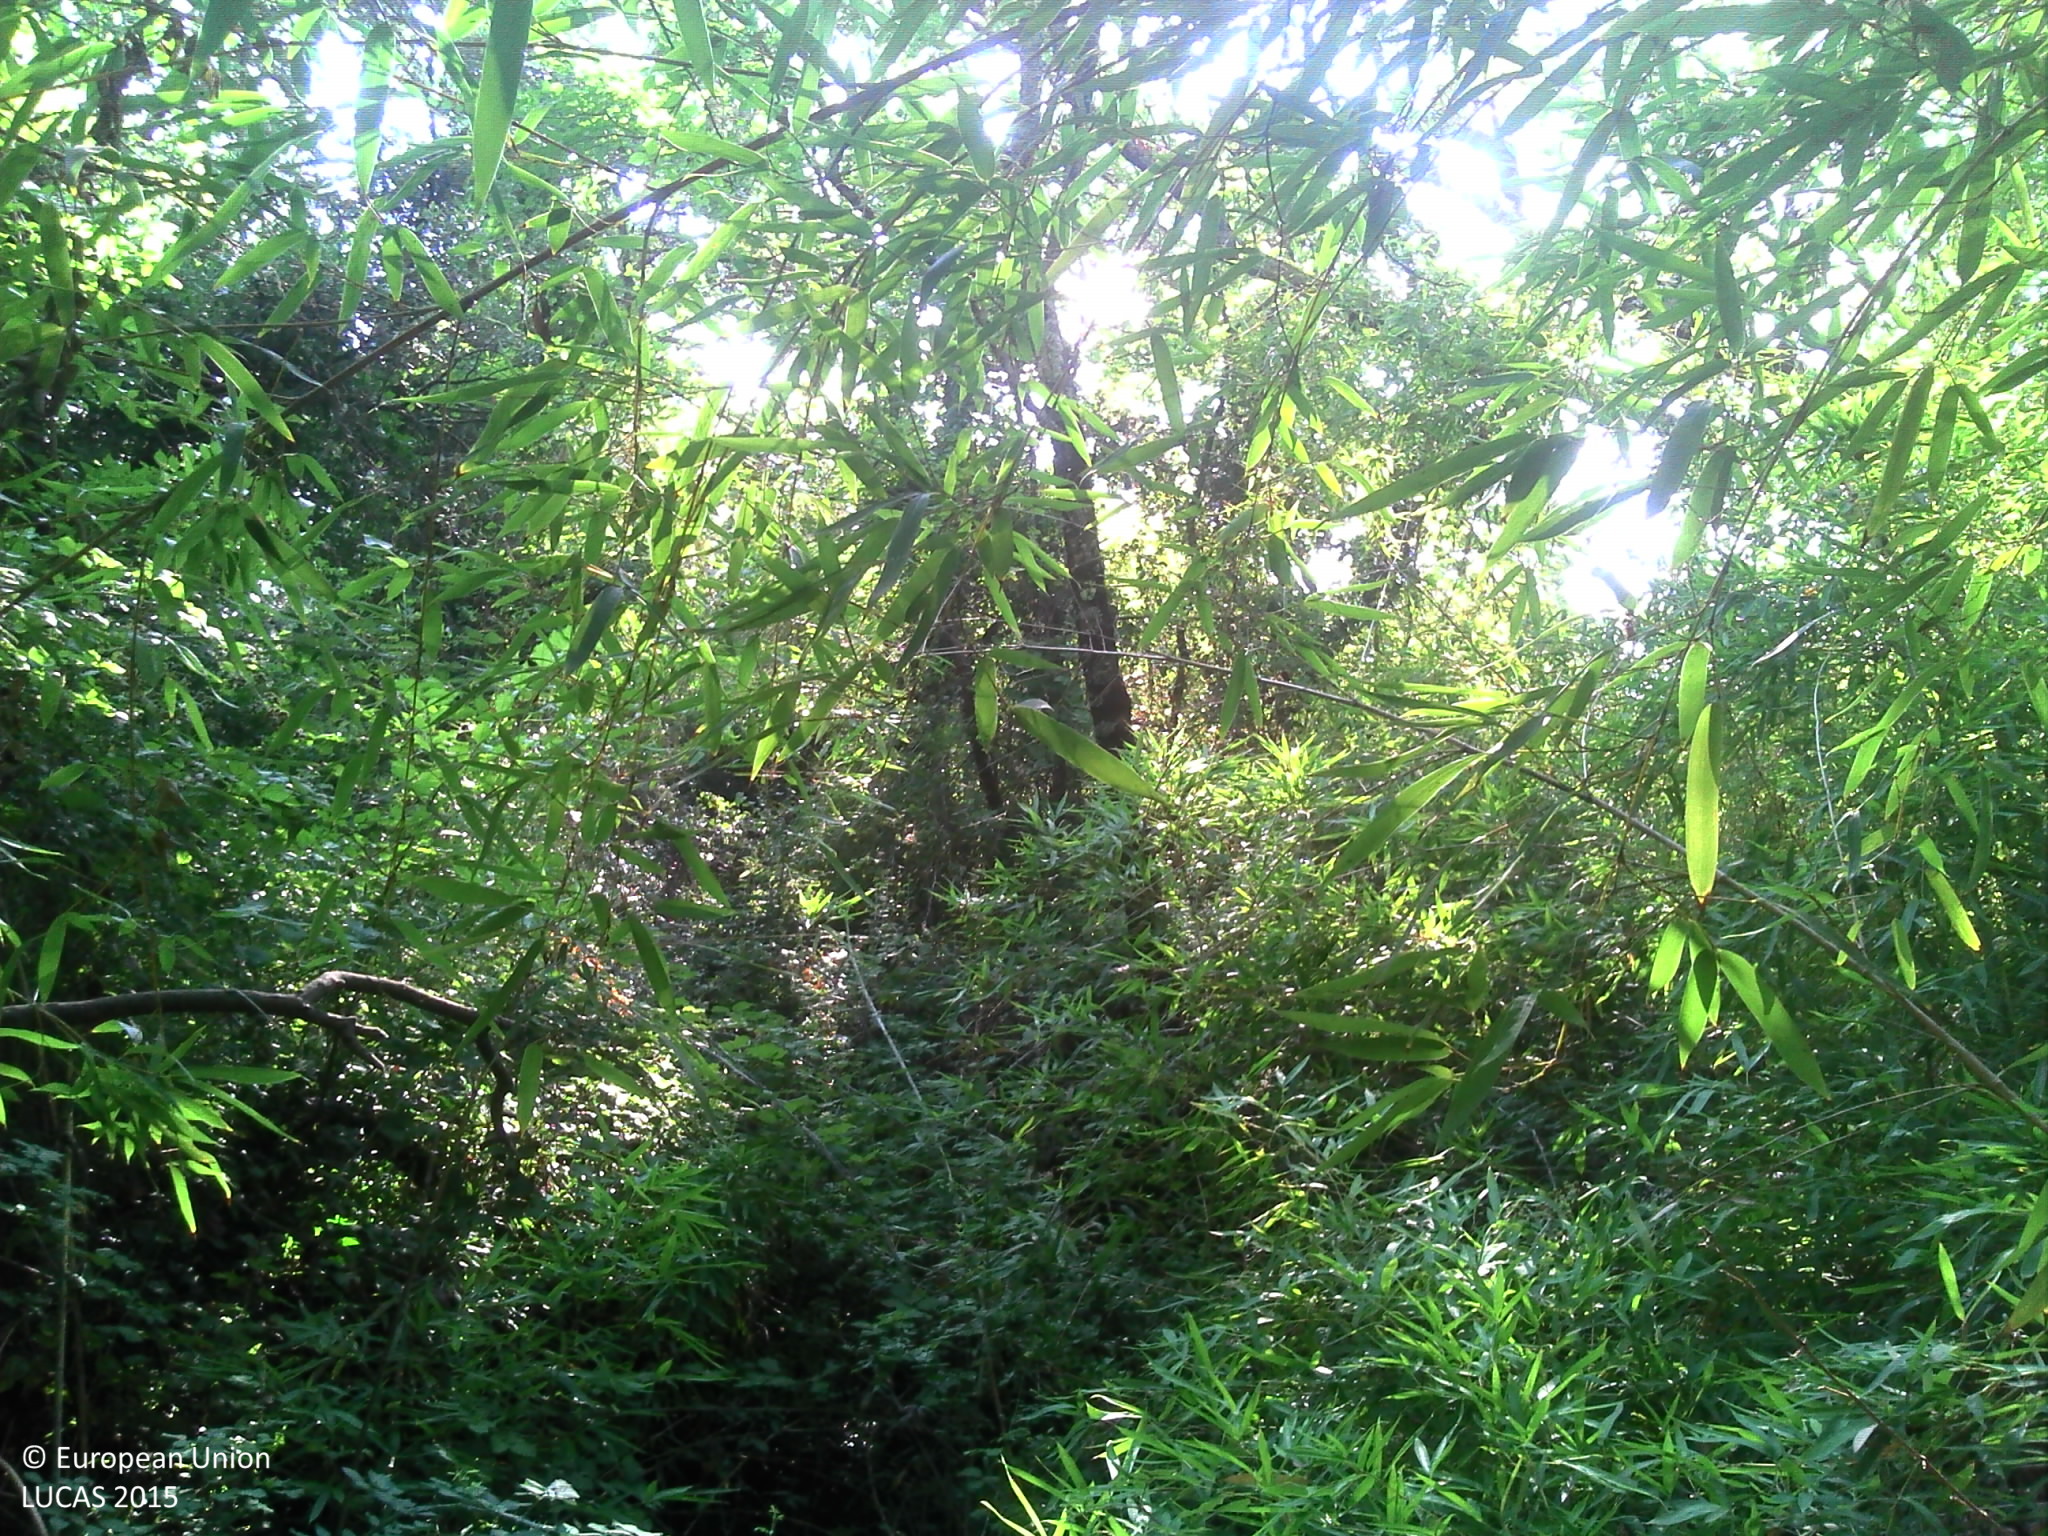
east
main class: Woodland
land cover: Broadleaved woodland
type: boreal forest
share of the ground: > 75 %
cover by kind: broadleaved forest trees 90 %, shrubs 10 %
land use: Semi-natural and natural areas not in use
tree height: > 5 m
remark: Temporary flooded
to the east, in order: Broadleaved woodland; Tracks; Broadleaved woodland; Grassland without tree/shrub cover; Shrubland with sparse tree cover; Grassland without tree/shrub cover; Abandoned hedges; Ditches and canals; Abandoned hedges; Grassland without tree/shrub cover; Electric lines; Tracks
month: July
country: FR
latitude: 43.3840
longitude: 6.3675
